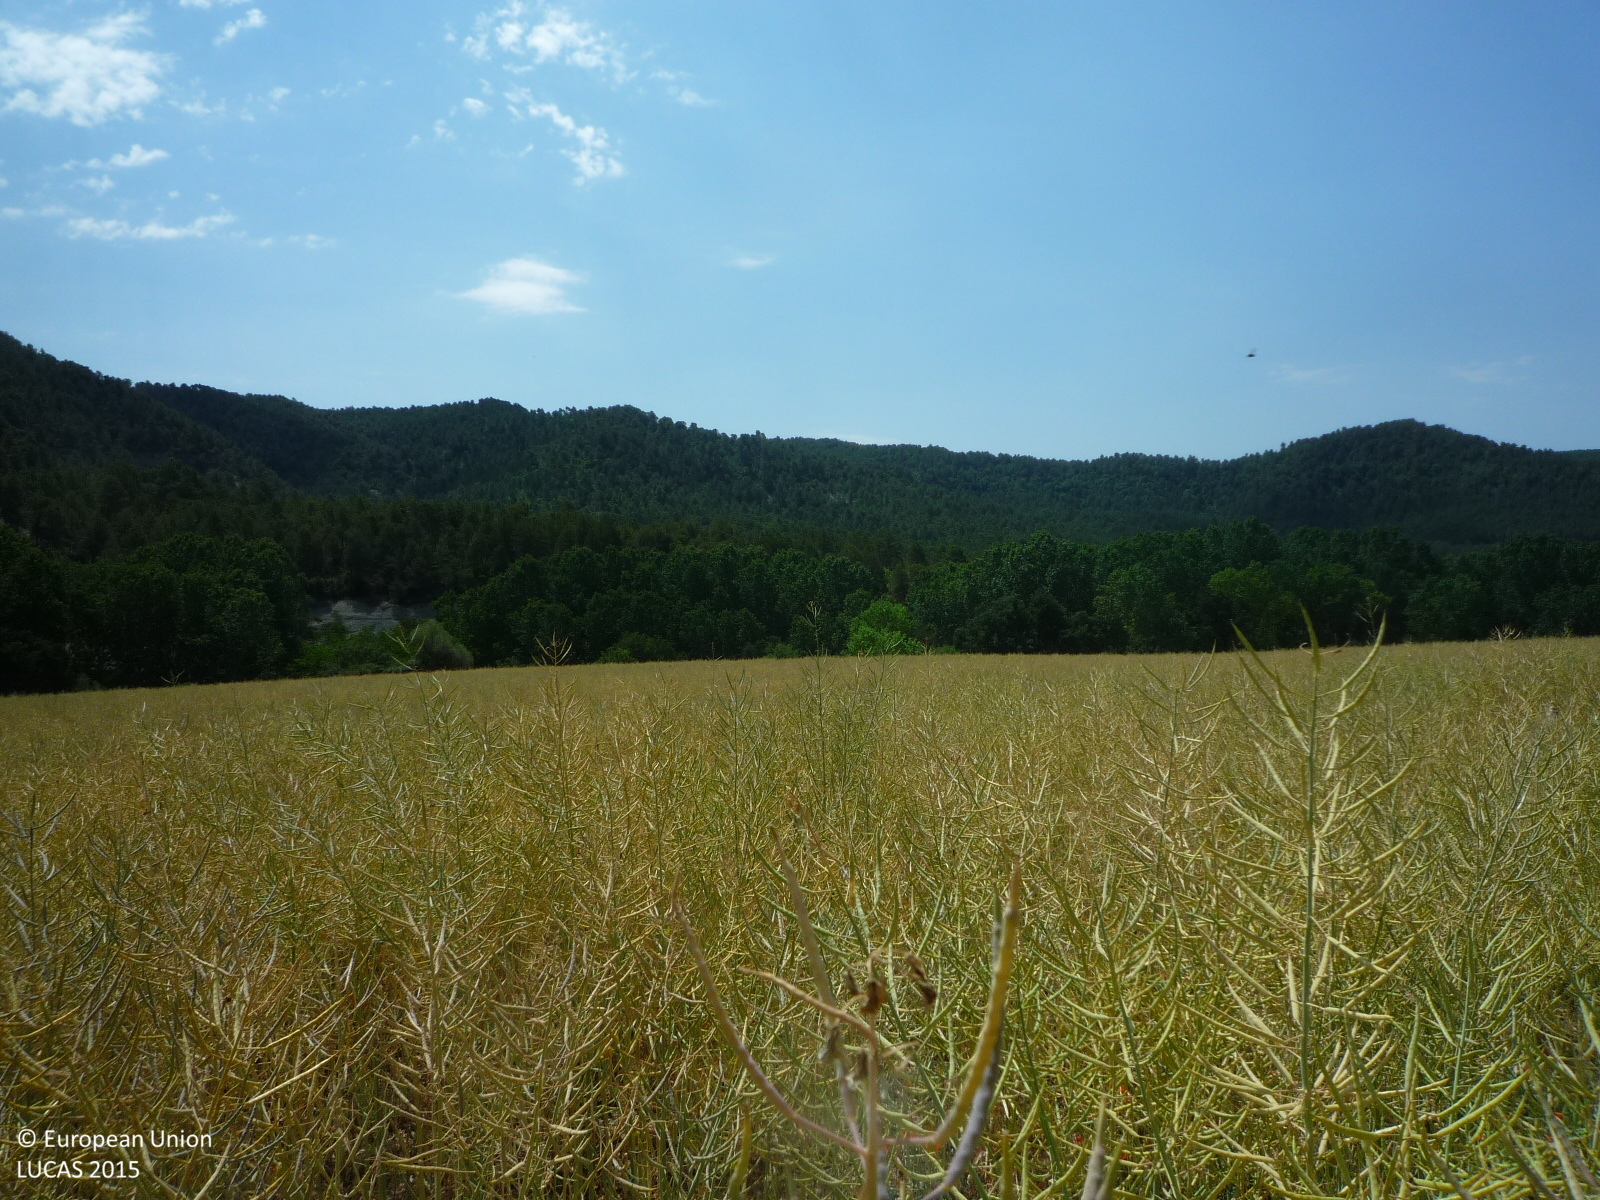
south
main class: Cropland
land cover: Rape and turnip rape
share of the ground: > 75 %
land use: Agriculture (excluding fallow land and kitchen gardens)
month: June
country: ES
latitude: 41.7740
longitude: 1.9911
